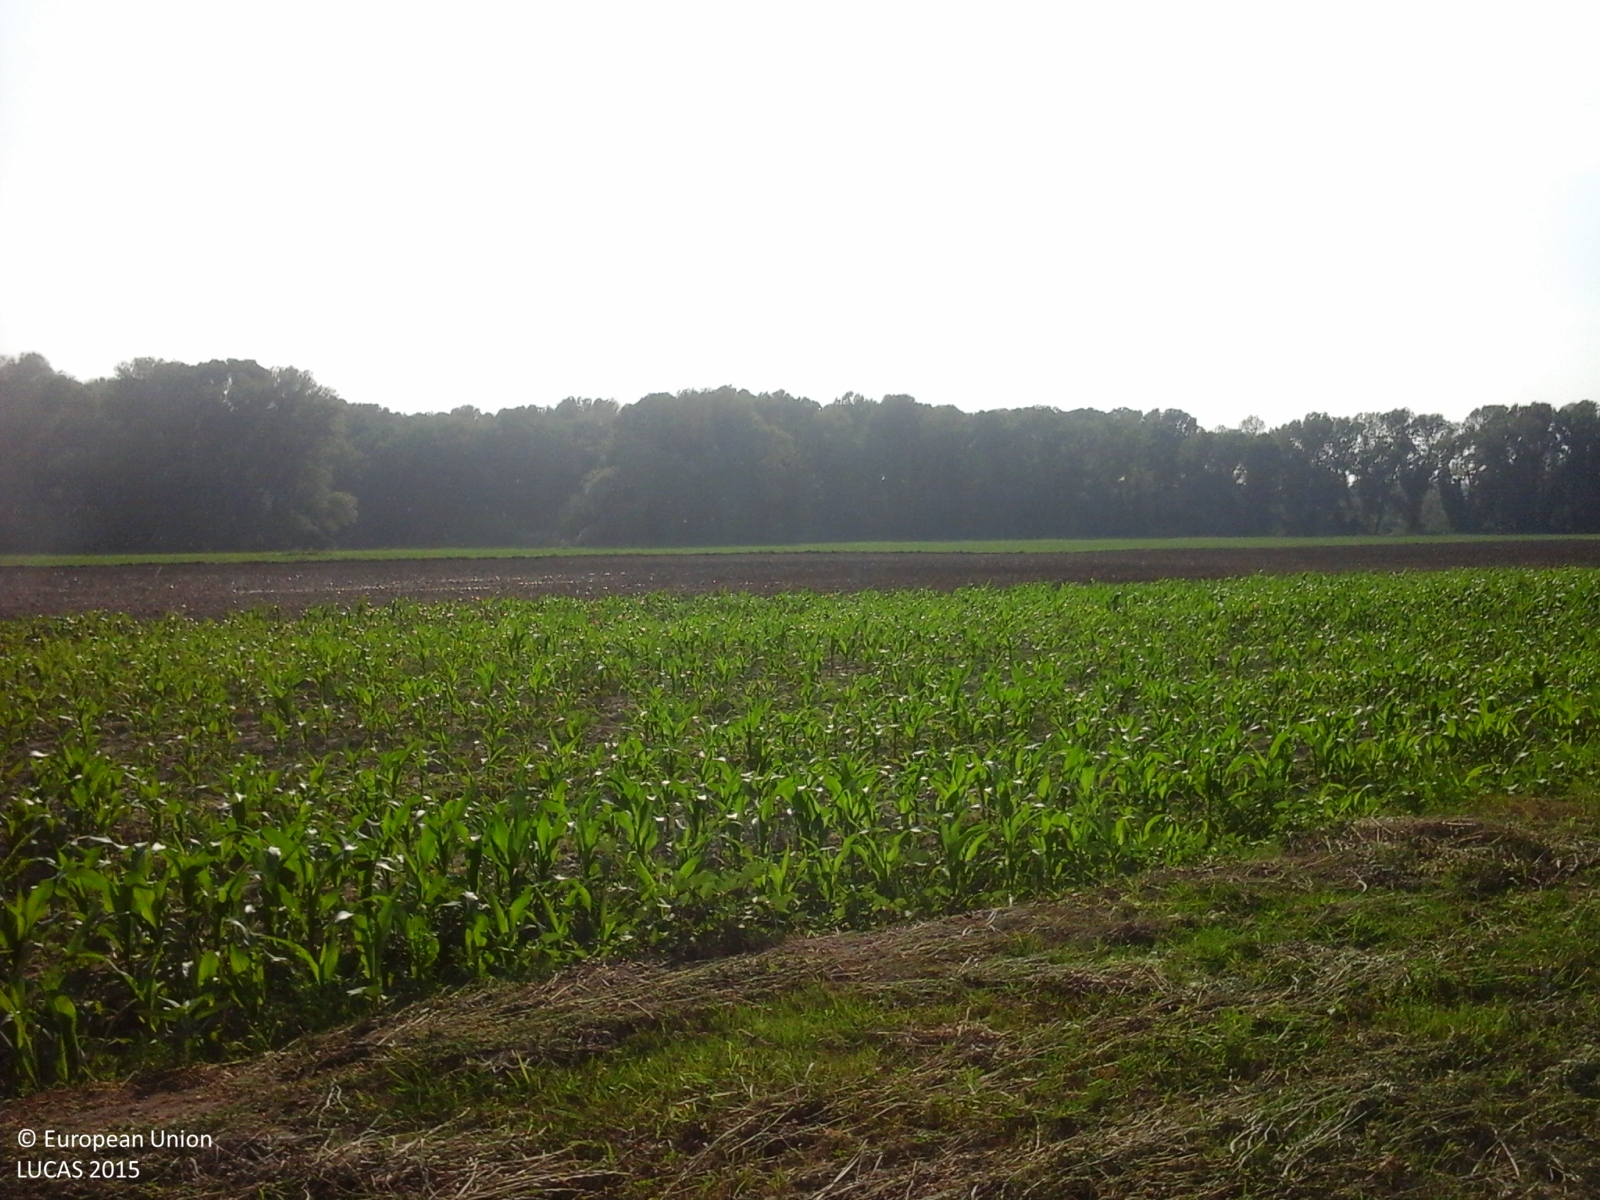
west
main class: Cropland
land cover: Other leguminous and mixtures for fodder
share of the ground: > 75 %
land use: Agriculture (excluding fallow land and kitchen gardens)
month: June
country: IT
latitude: 40.5508
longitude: 15.1154
